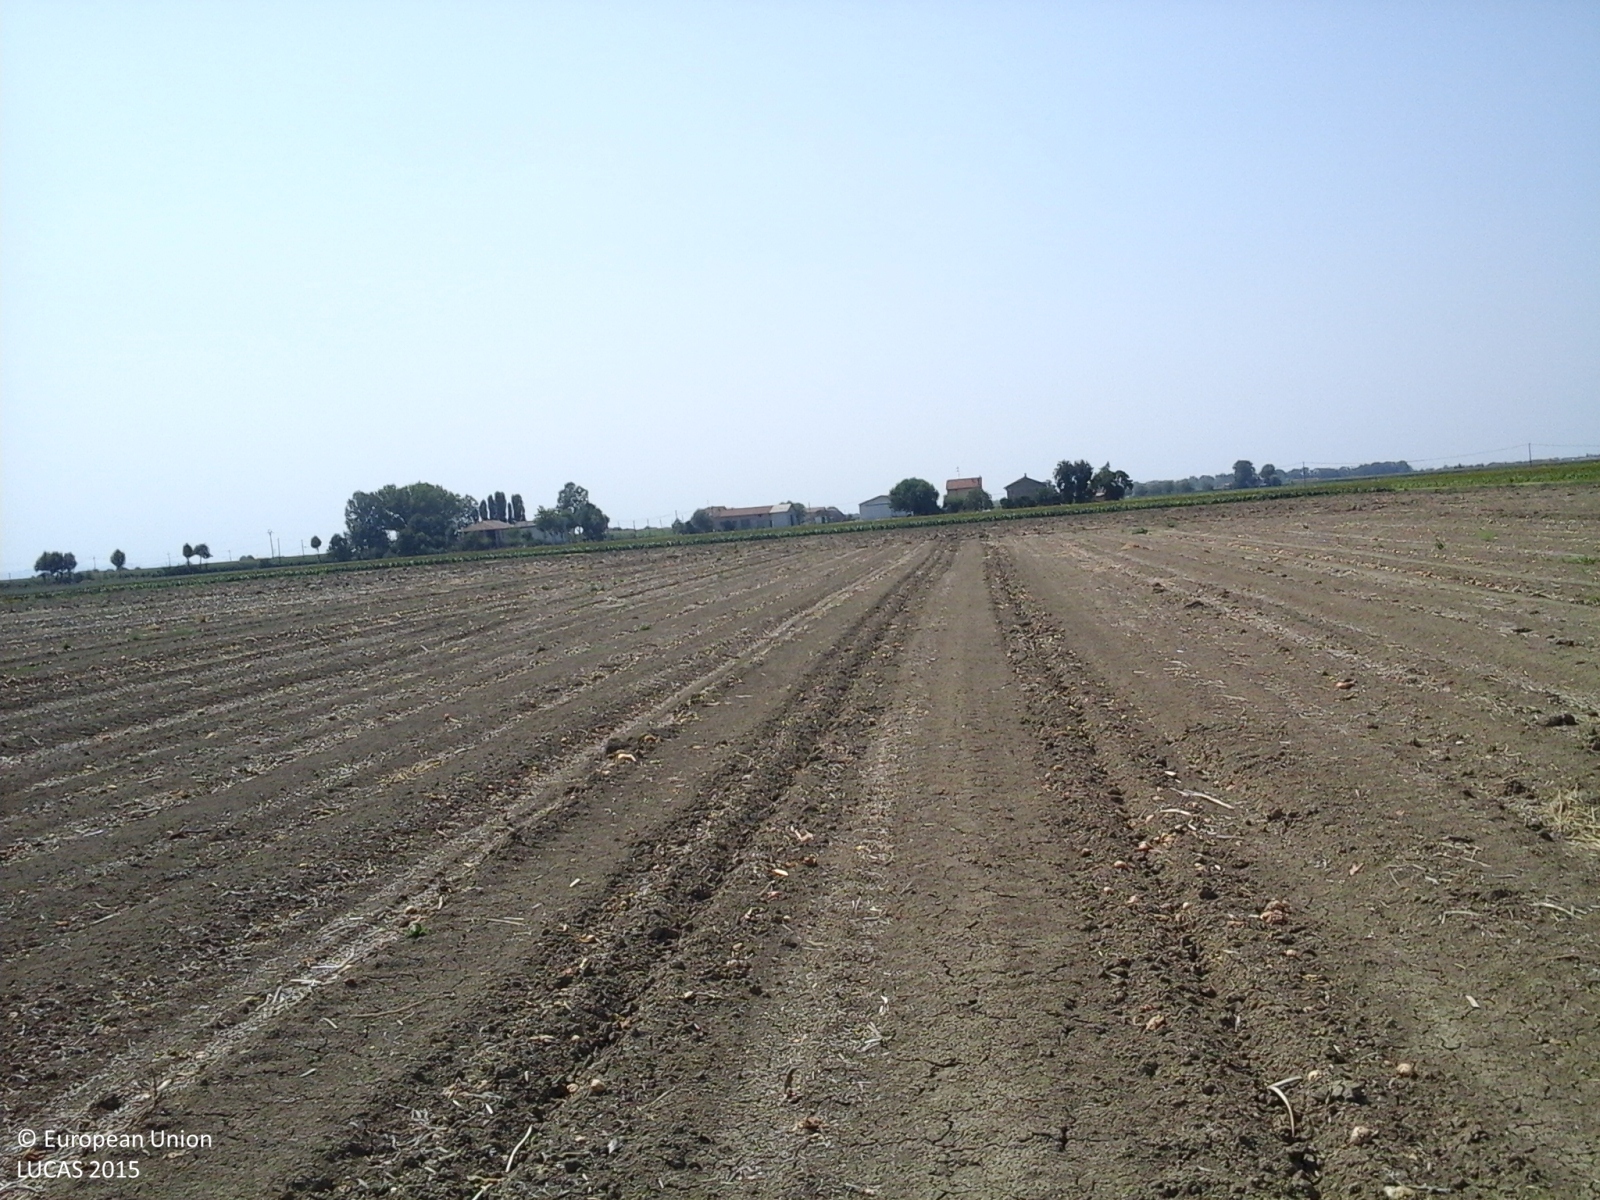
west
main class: Cropland
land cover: Other root crops
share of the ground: > 75 %
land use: Agriculture (excluding fallow land and kitchen gardens)
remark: Harvested field
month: July
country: IT
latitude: 44.4991
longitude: 11.6942
